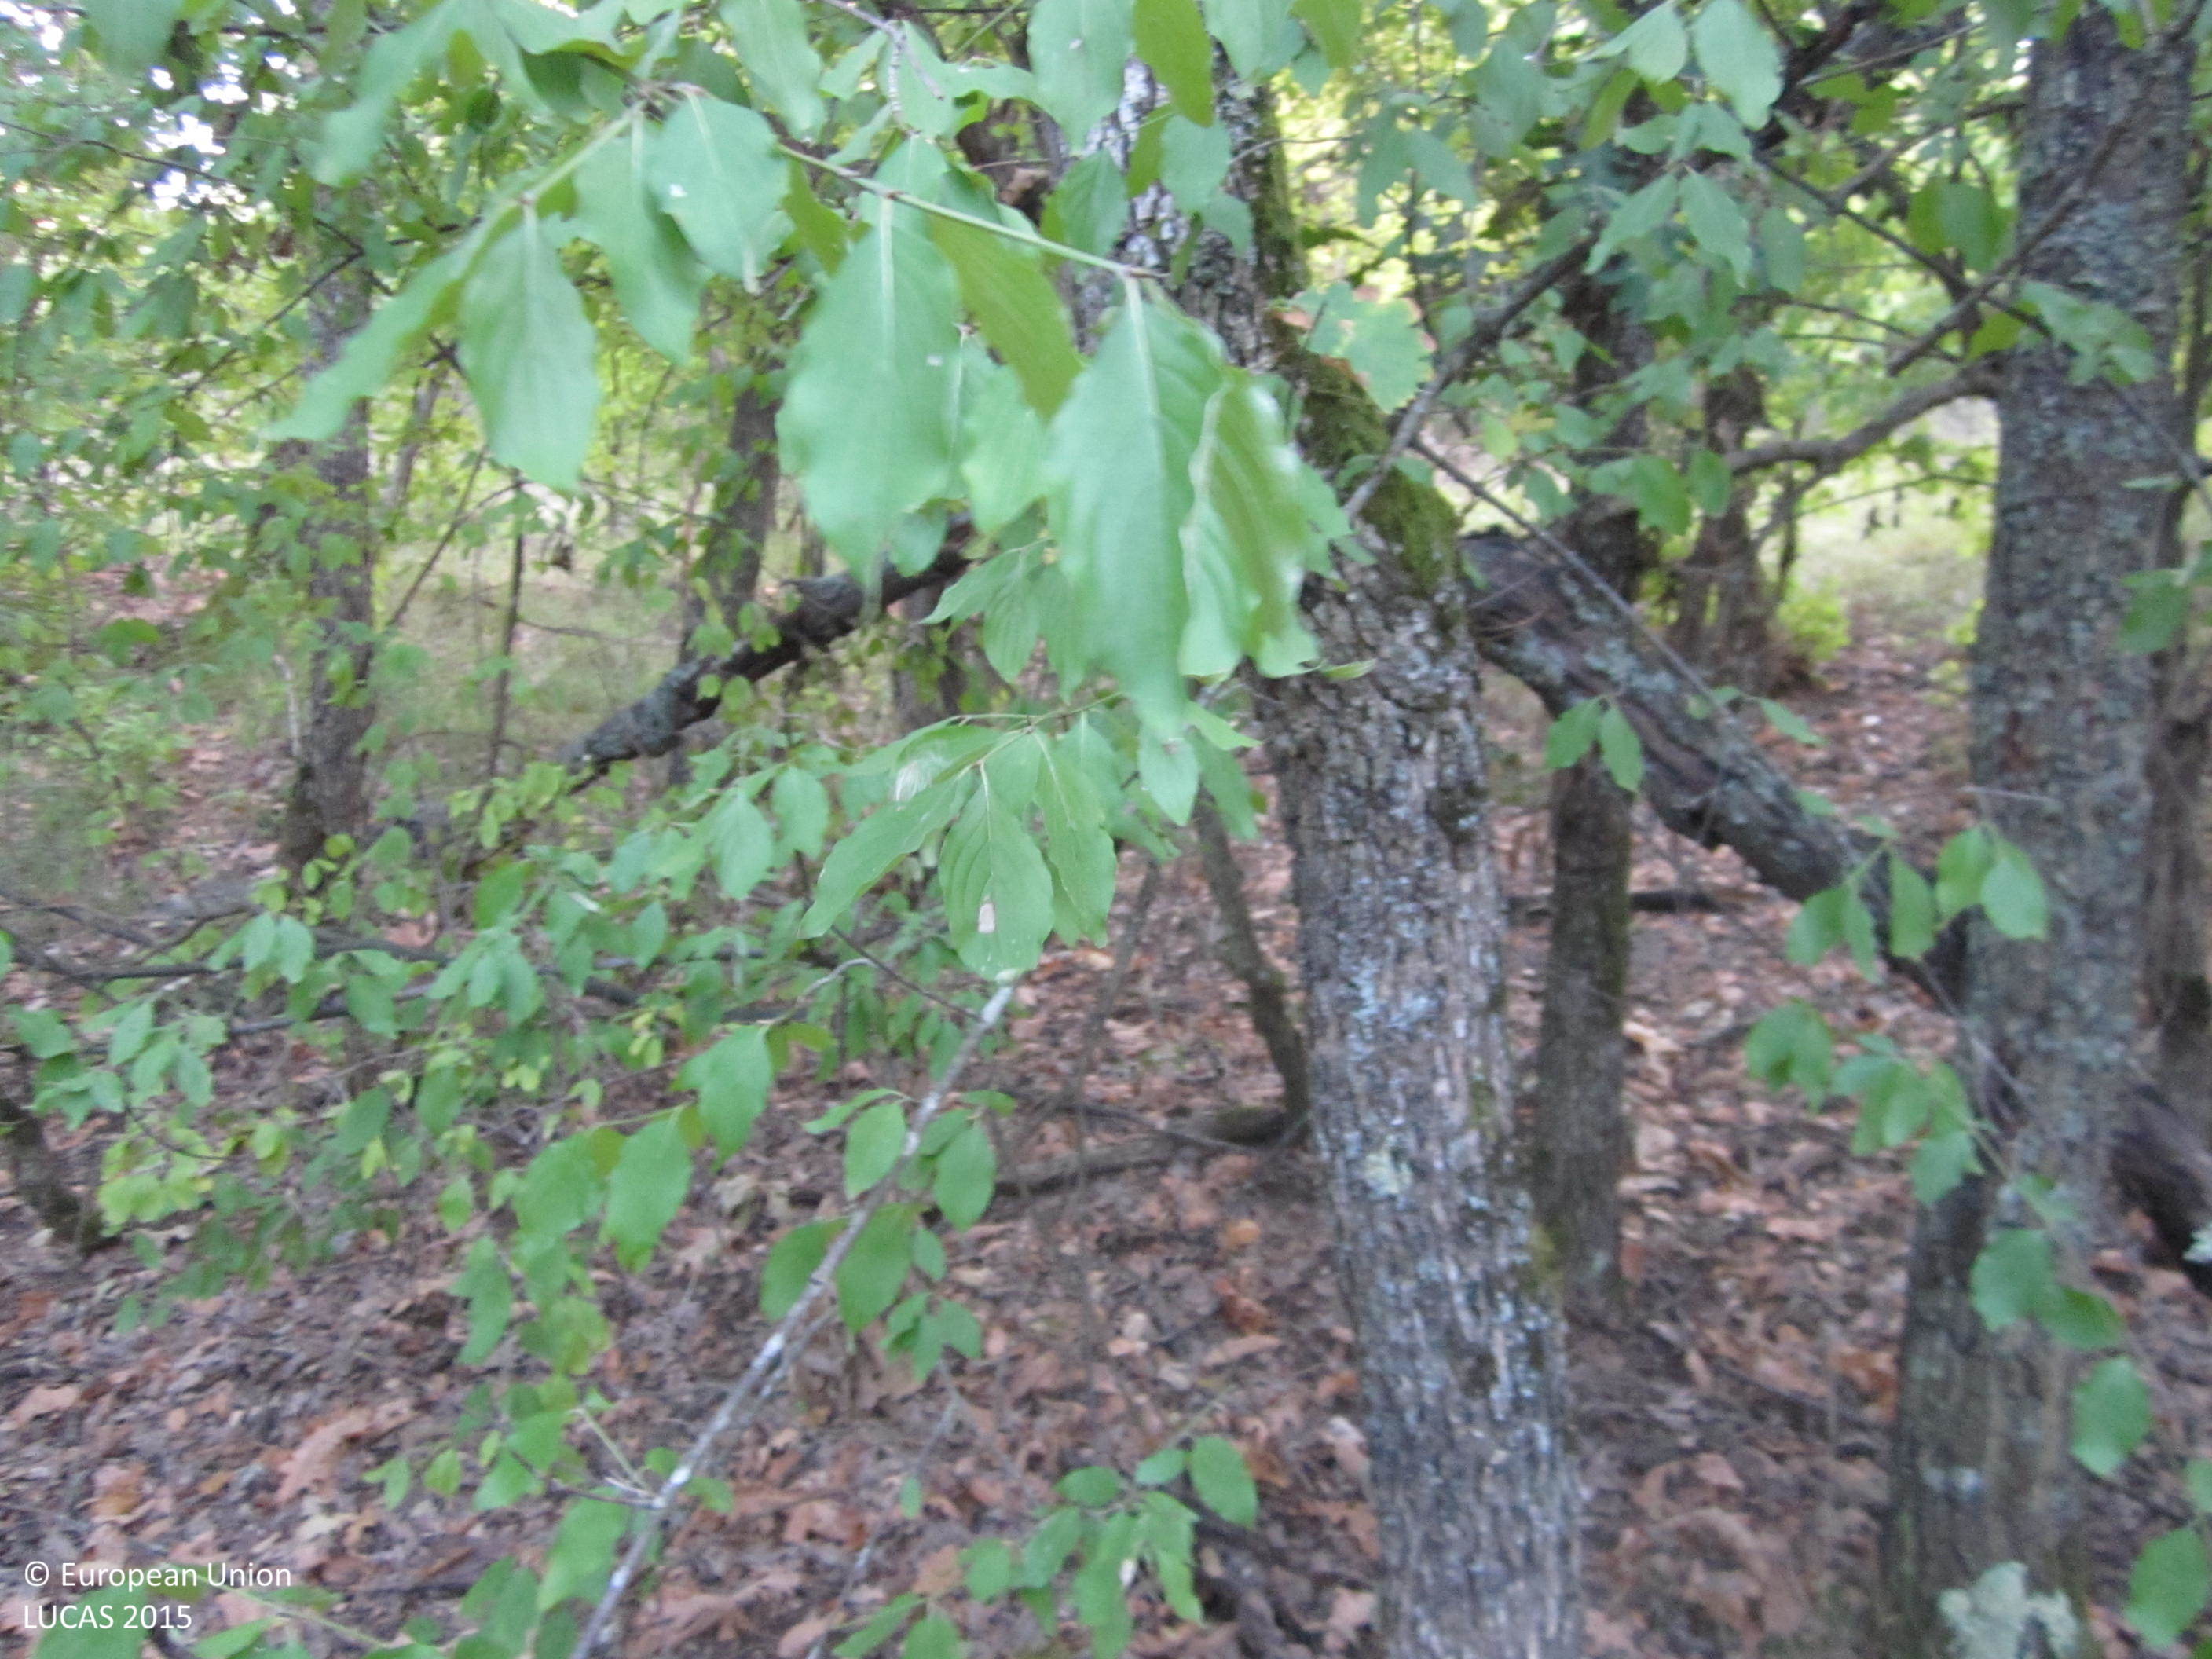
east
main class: Woodland
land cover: Broadleaved woodland
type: thermophilous deciduous forest
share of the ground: > 75 %
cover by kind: broadleaved forest trees 80 %, herbaceous plants 10 %, unconsolidated bare surface 10 %
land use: Forestry
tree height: > 5 m
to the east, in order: Broadleaved woodland; Rivers and streams; Broadleaved woodland; Tracks; Broadleaved woodland; Rivers and streams; Broadleaved woodland
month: September
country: BG
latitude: 42.2402
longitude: 27.0812
